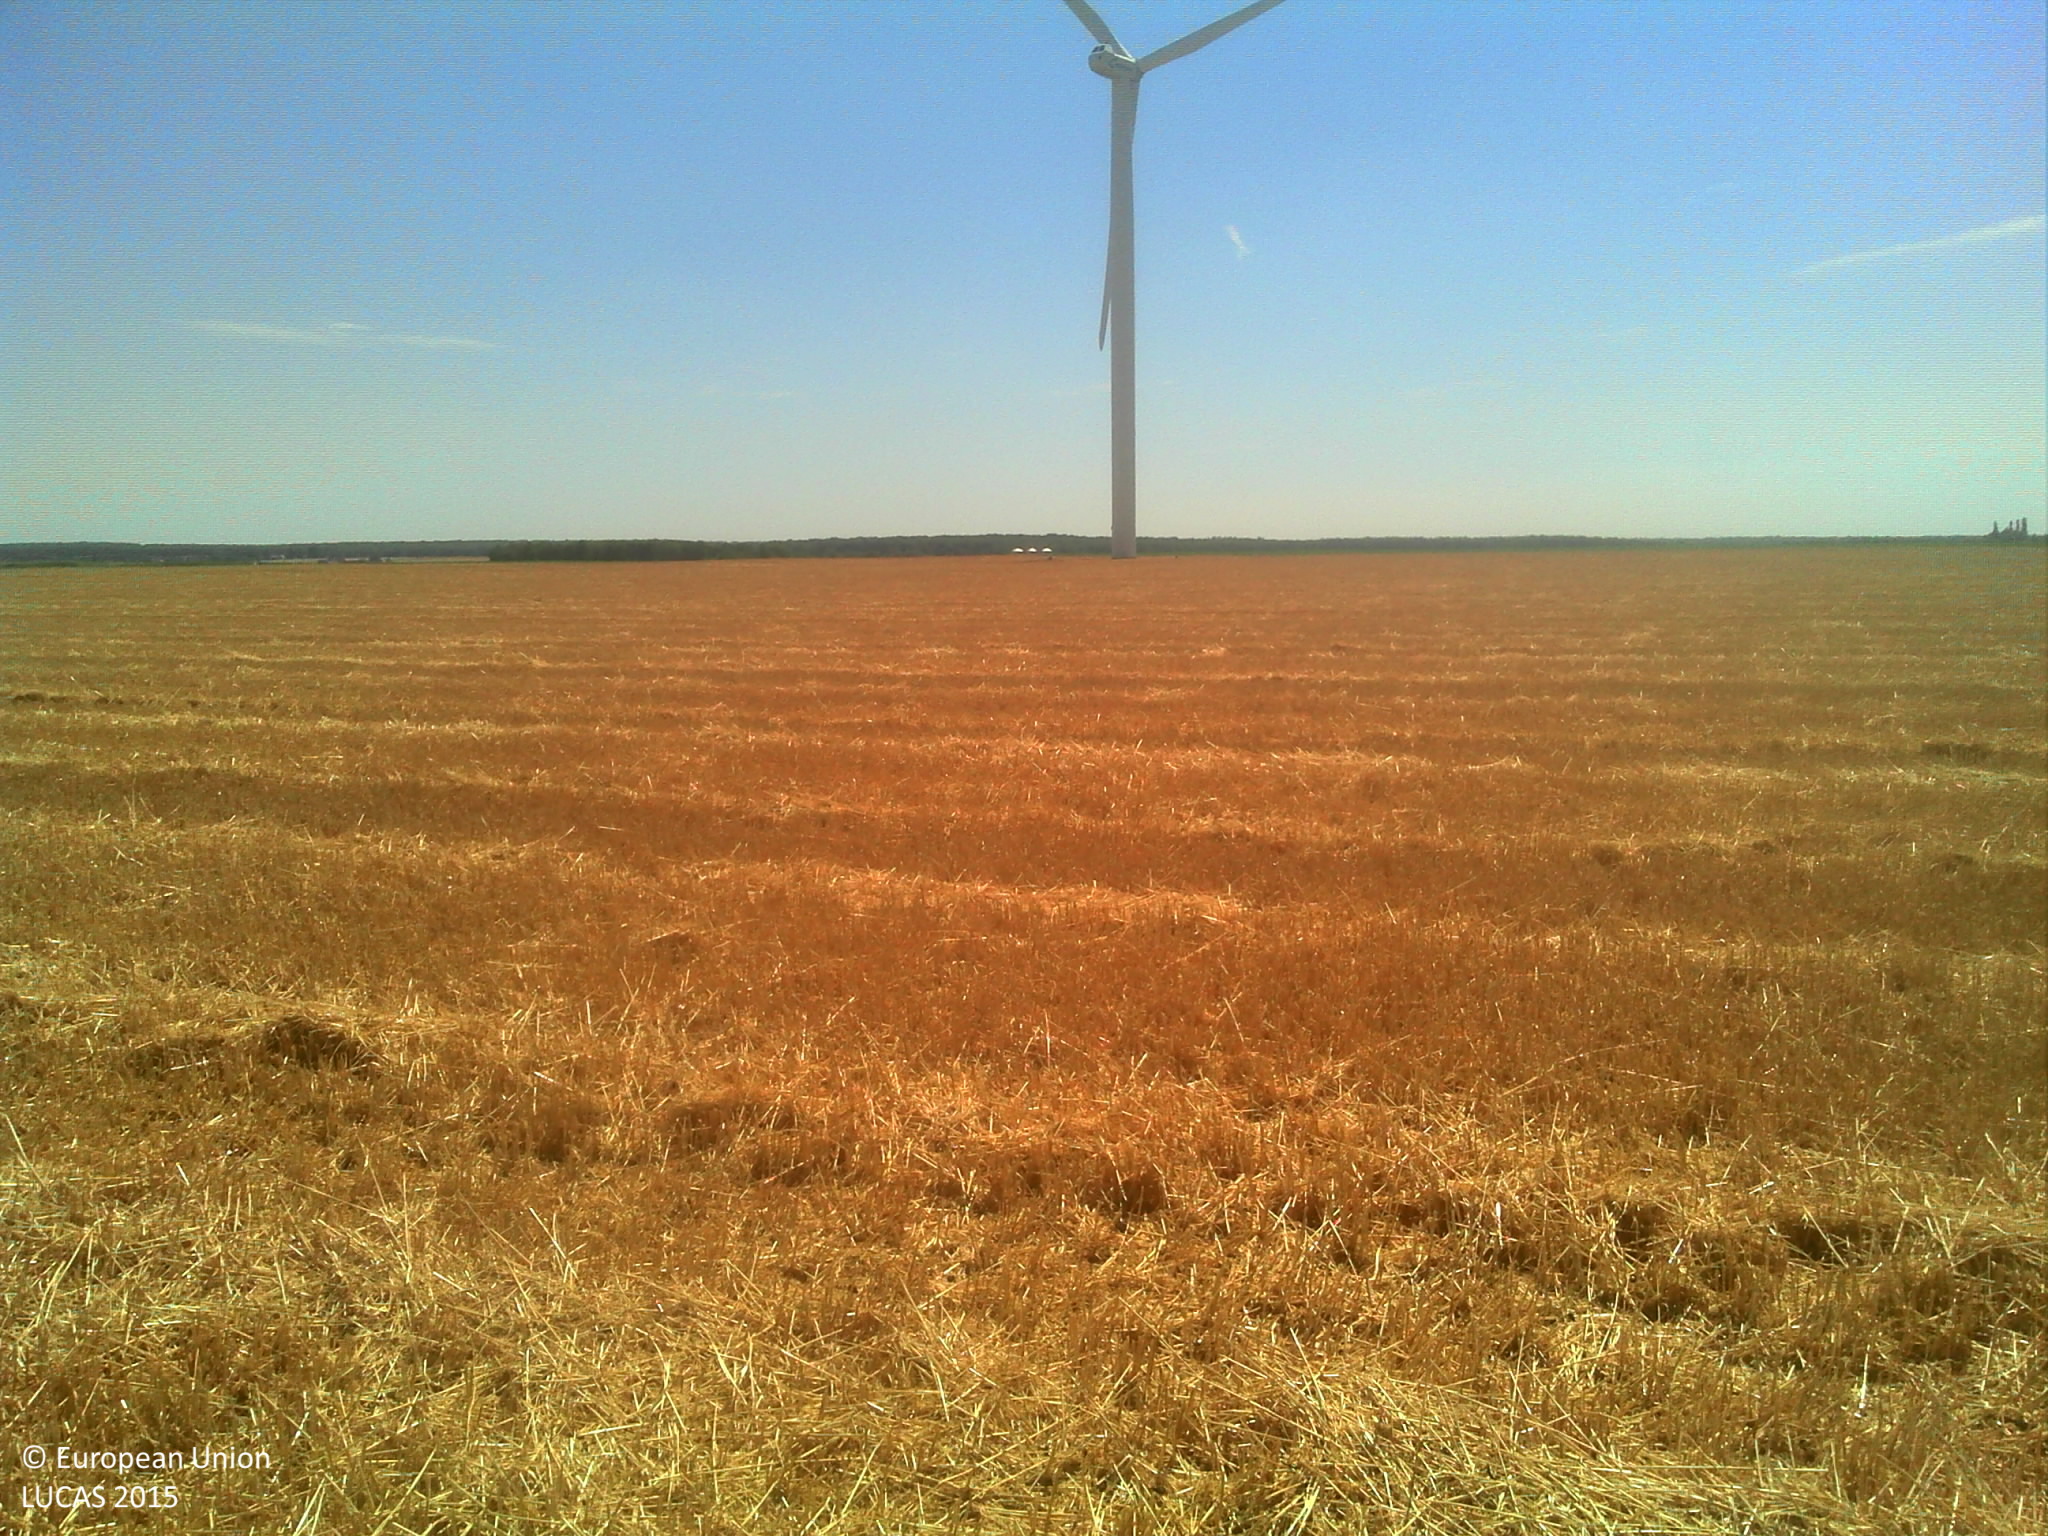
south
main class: Cropland
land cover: Durum wheat
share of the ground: > 75 %
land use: Agriculture (excluding fallow land and kitchen gardens)
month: July
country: FR
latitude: 47.9194
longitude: 1.3524
